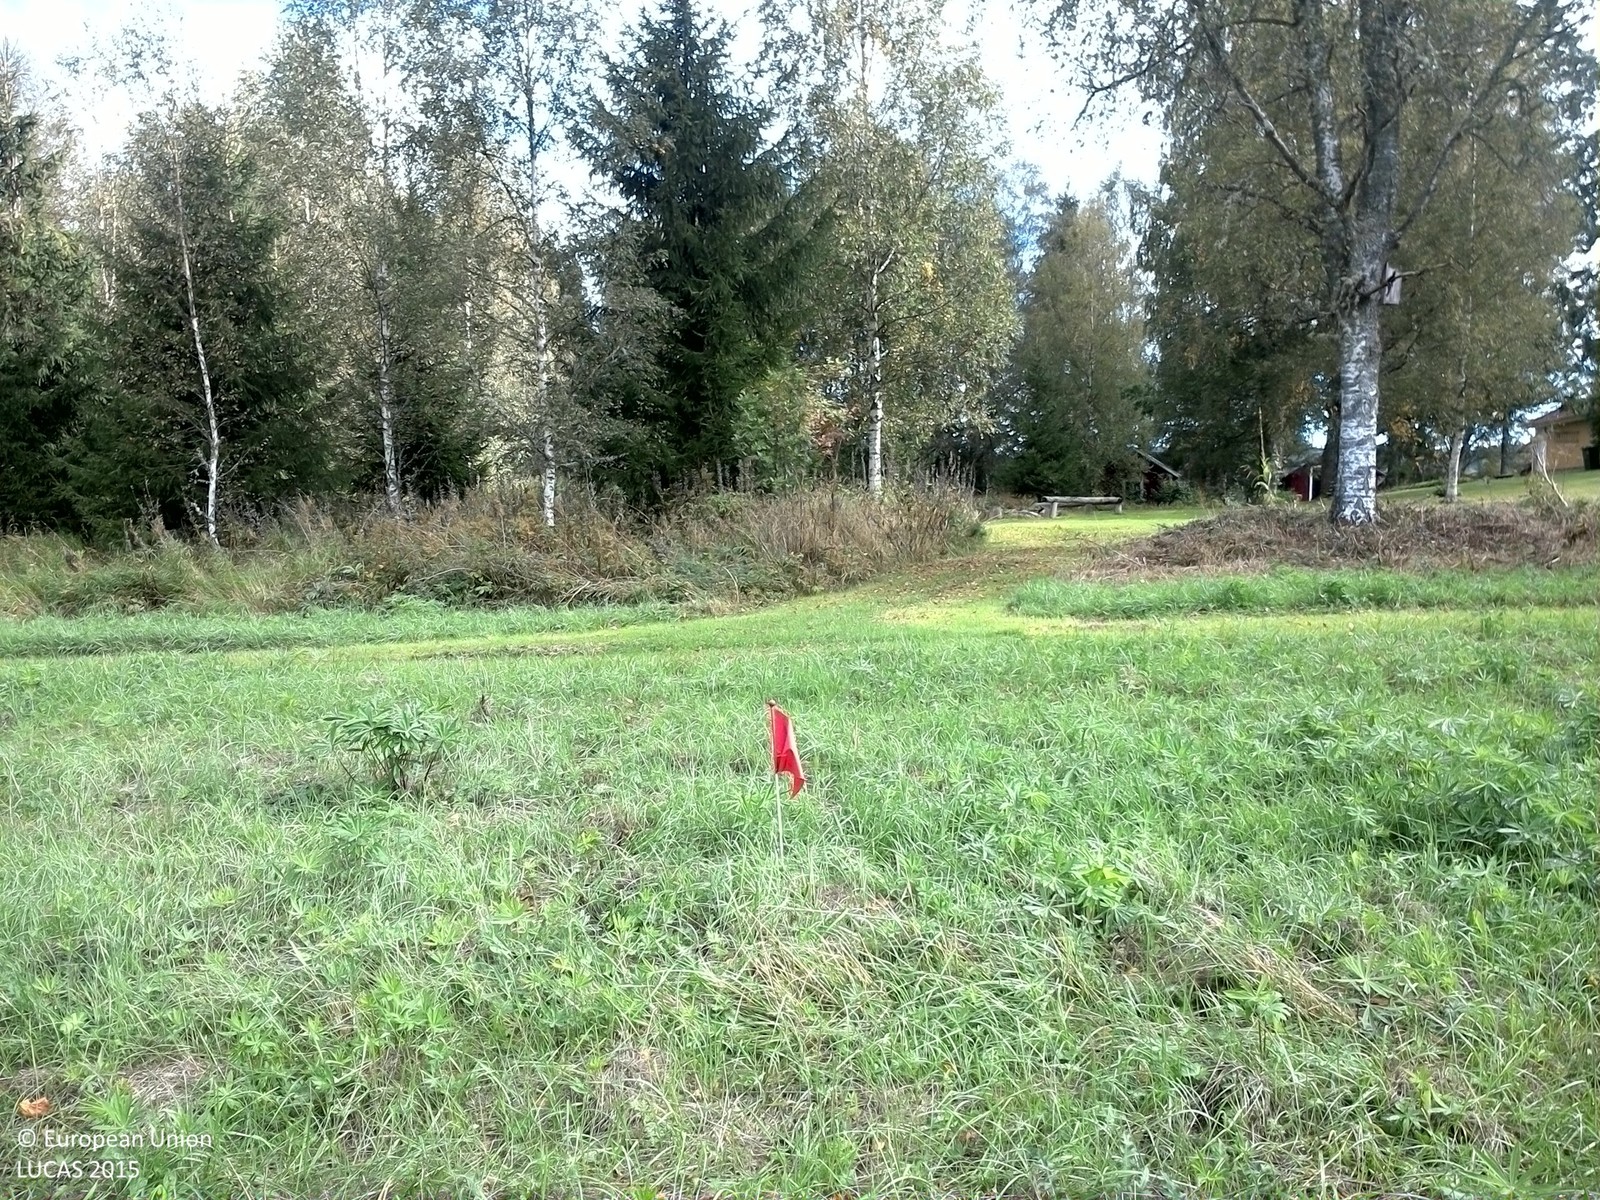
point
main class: Grassland
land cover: Grassland without tree/shrub cover
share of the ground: > 75 %
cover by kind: herbaceous plants 90 %, consolidated bare surface 10 %
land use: Agriculture (excluding fallow land and kitchen gardens)
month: September
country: SE
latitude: 59.7477
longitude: 13.2127
